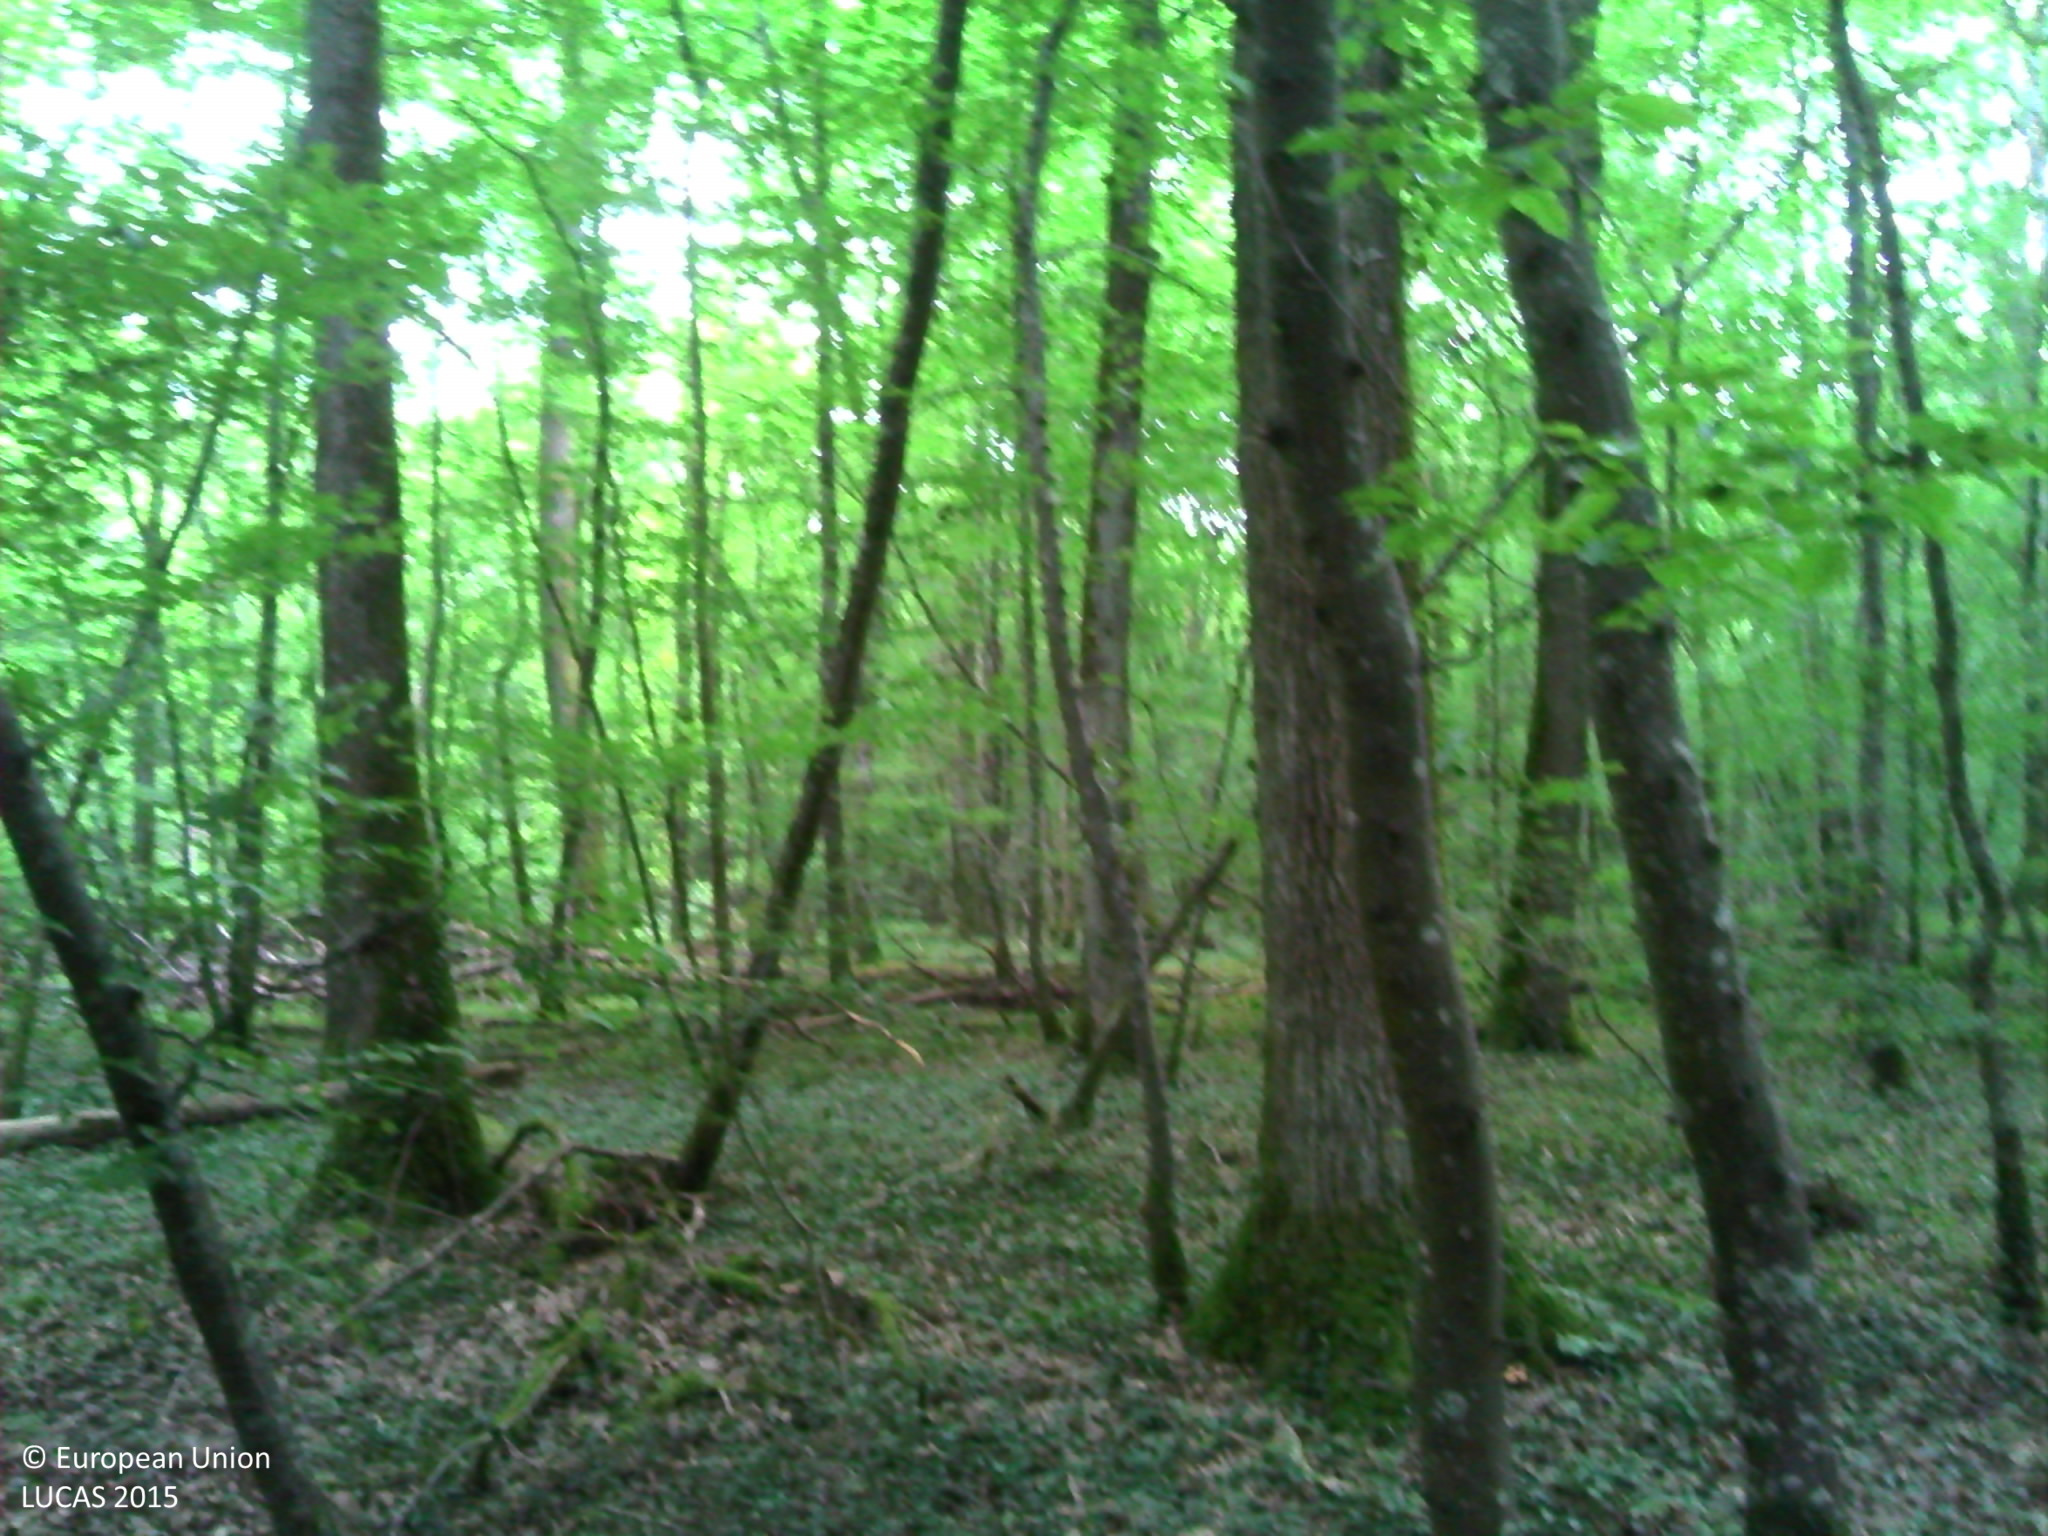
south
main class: Woodland
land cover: Broadleaved woodland
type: beech forest
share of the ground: > 75 %
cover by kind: broadleaved forest trees 90 %, herbaceous plants 10 %
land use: Forestry
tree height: > 5 m
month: July
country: FR
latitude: 47.3158
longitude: 3.6074
